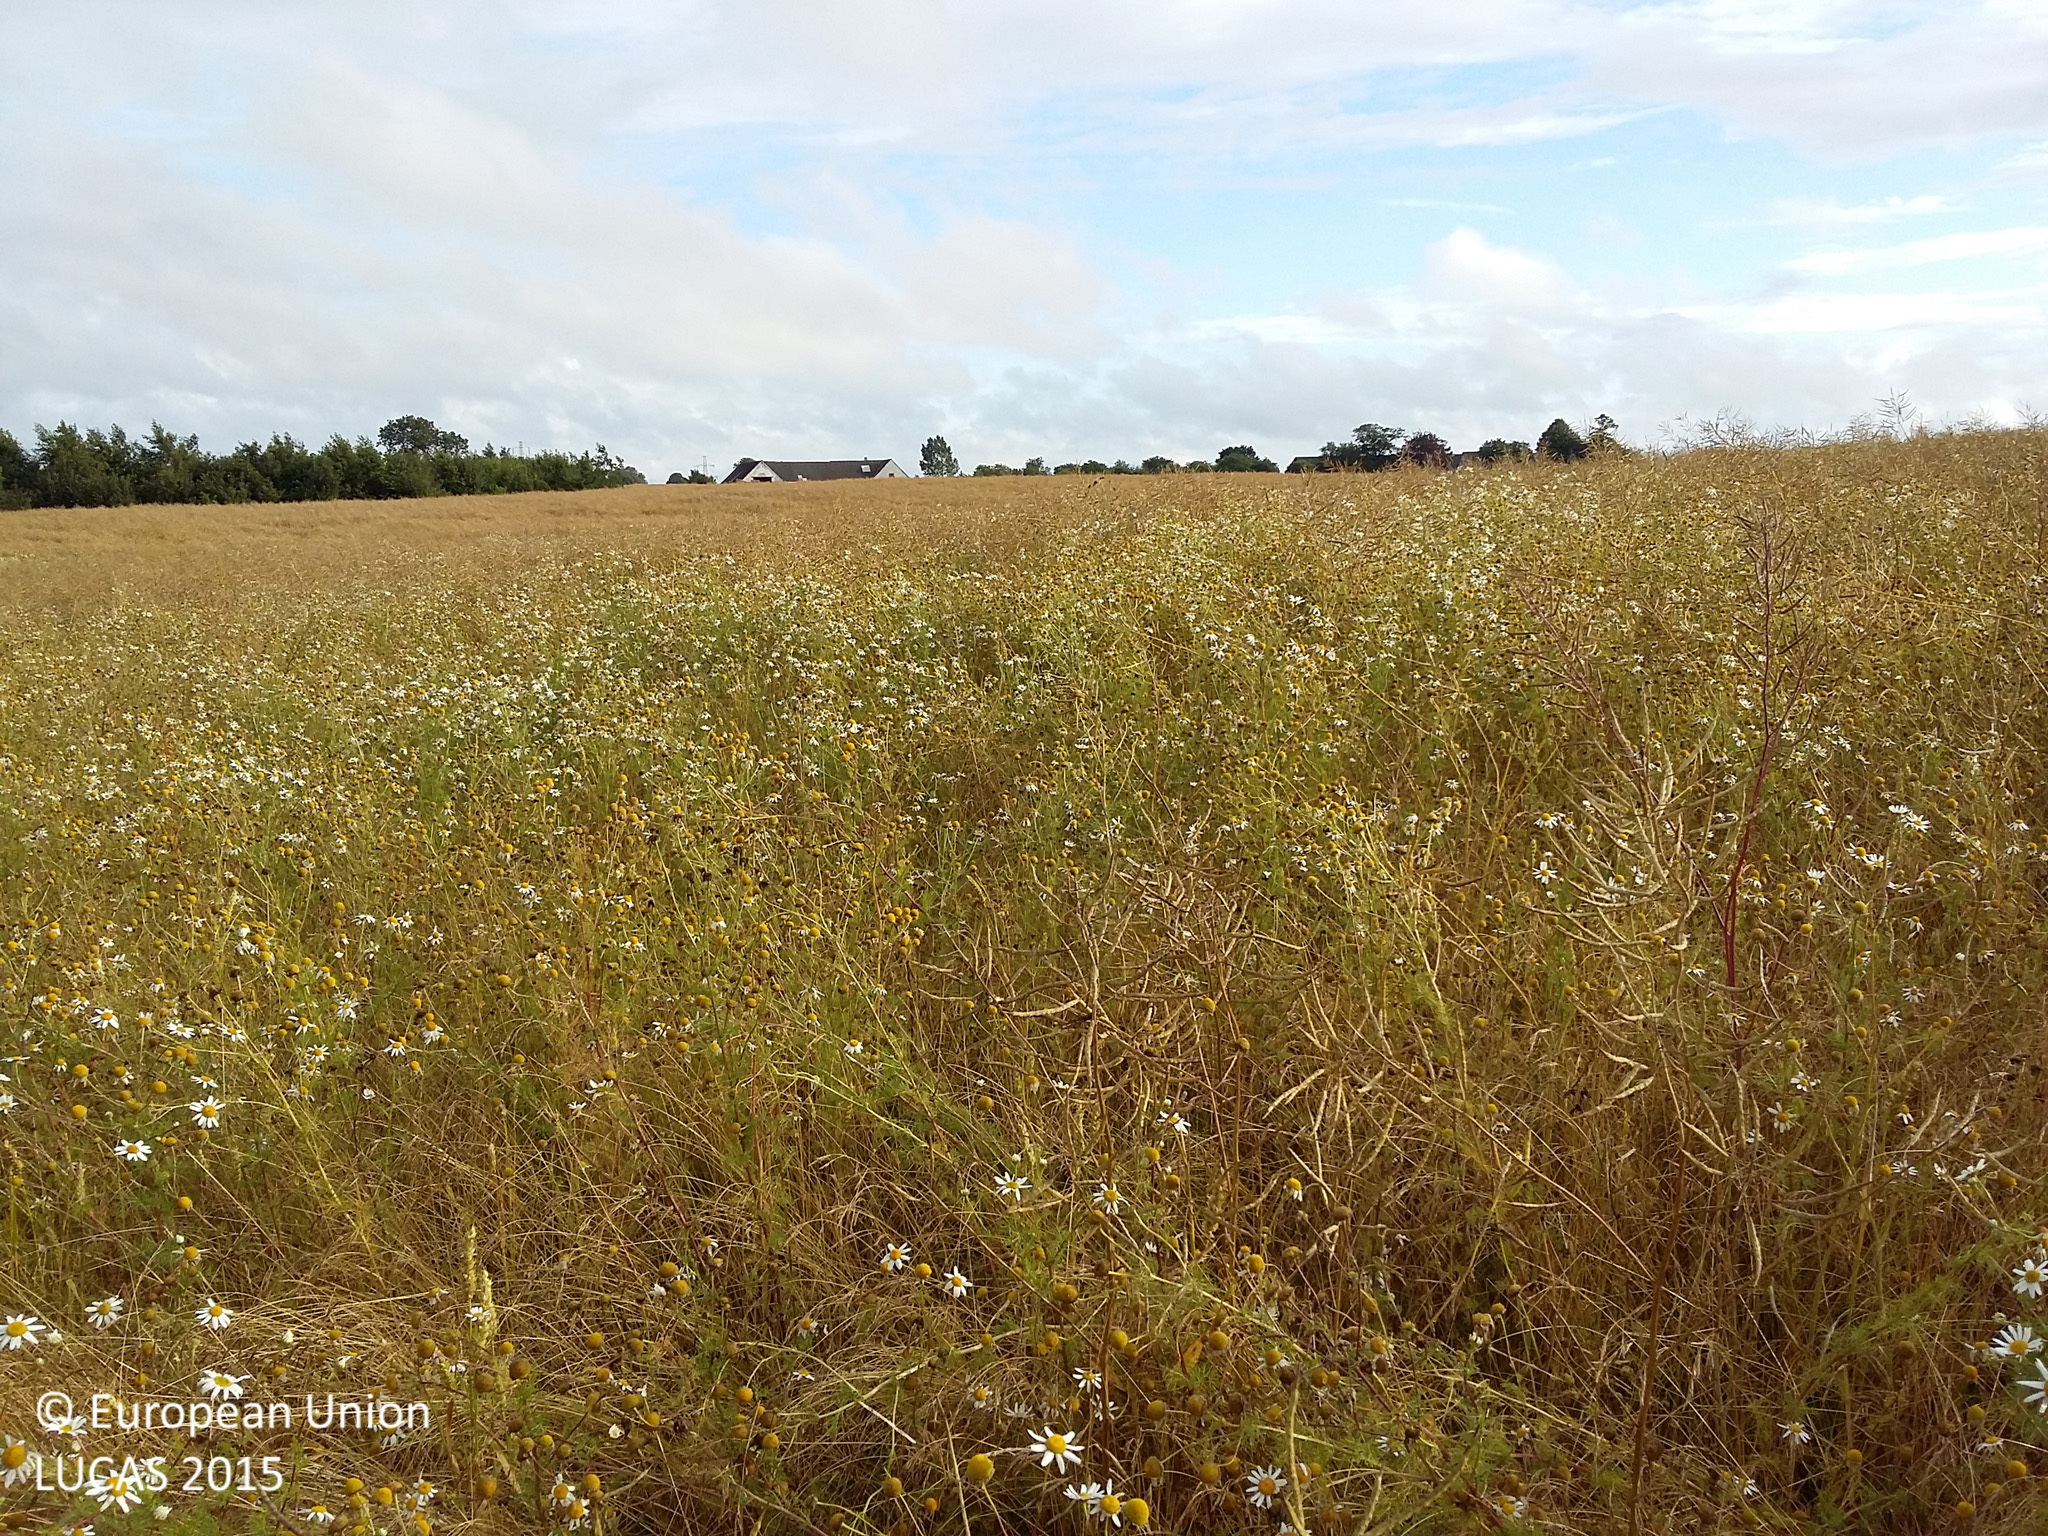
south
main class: Cropland
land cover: Rape and turnip rape
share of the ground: > 75 %
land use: Agriculture (excluding fallow land and kitchen gardens)
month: July
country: DK
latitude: 55.8640
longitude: 12.1551
